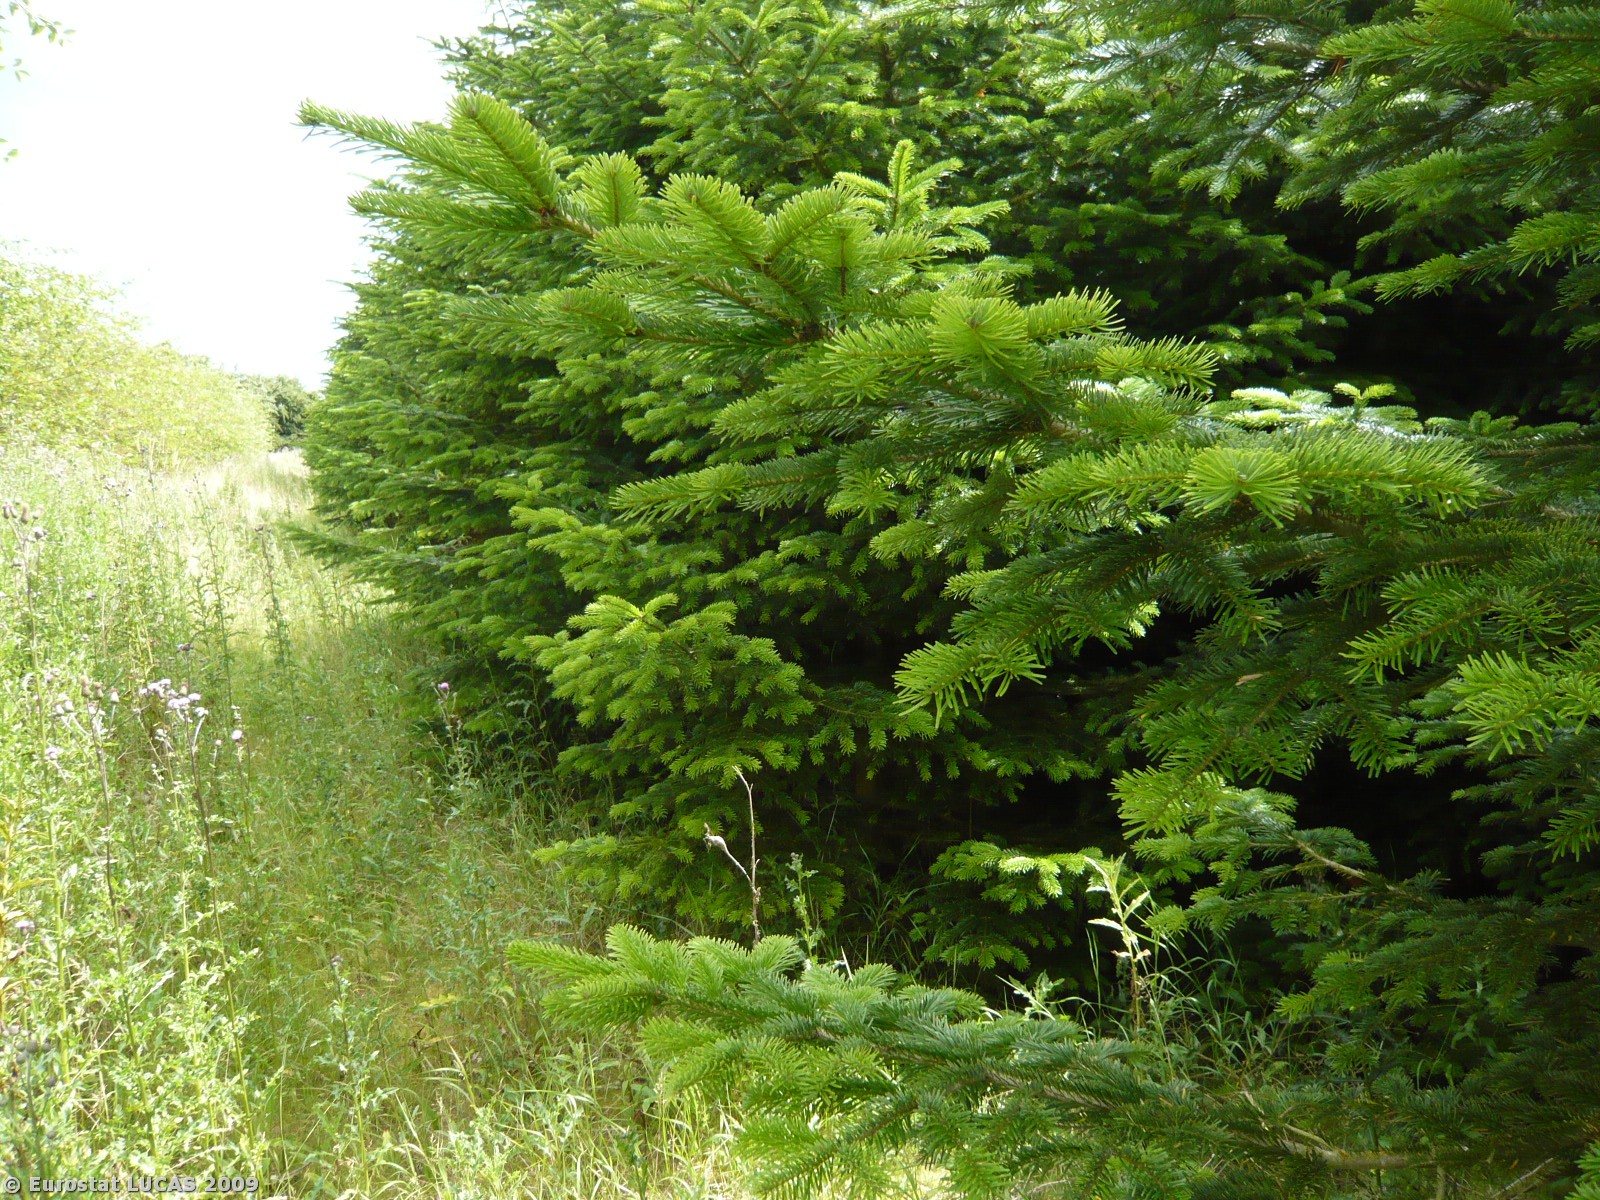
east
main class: Cropland
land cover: Cherry fruit
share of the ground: > 75 %
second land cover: Spontaneously vegetated surfaces
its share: 10 - 25 %
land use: Agriculture (excluding fallow land and kitchen gardens)
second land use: Fallow land
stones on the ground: < 10 %
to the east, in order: Cherry fruit; Coniferous woodland; Broadleaved woodland; Tracks; Broadleaved woodland; Barley
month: July
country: DK
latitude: 55.4851
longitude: 10.6482
